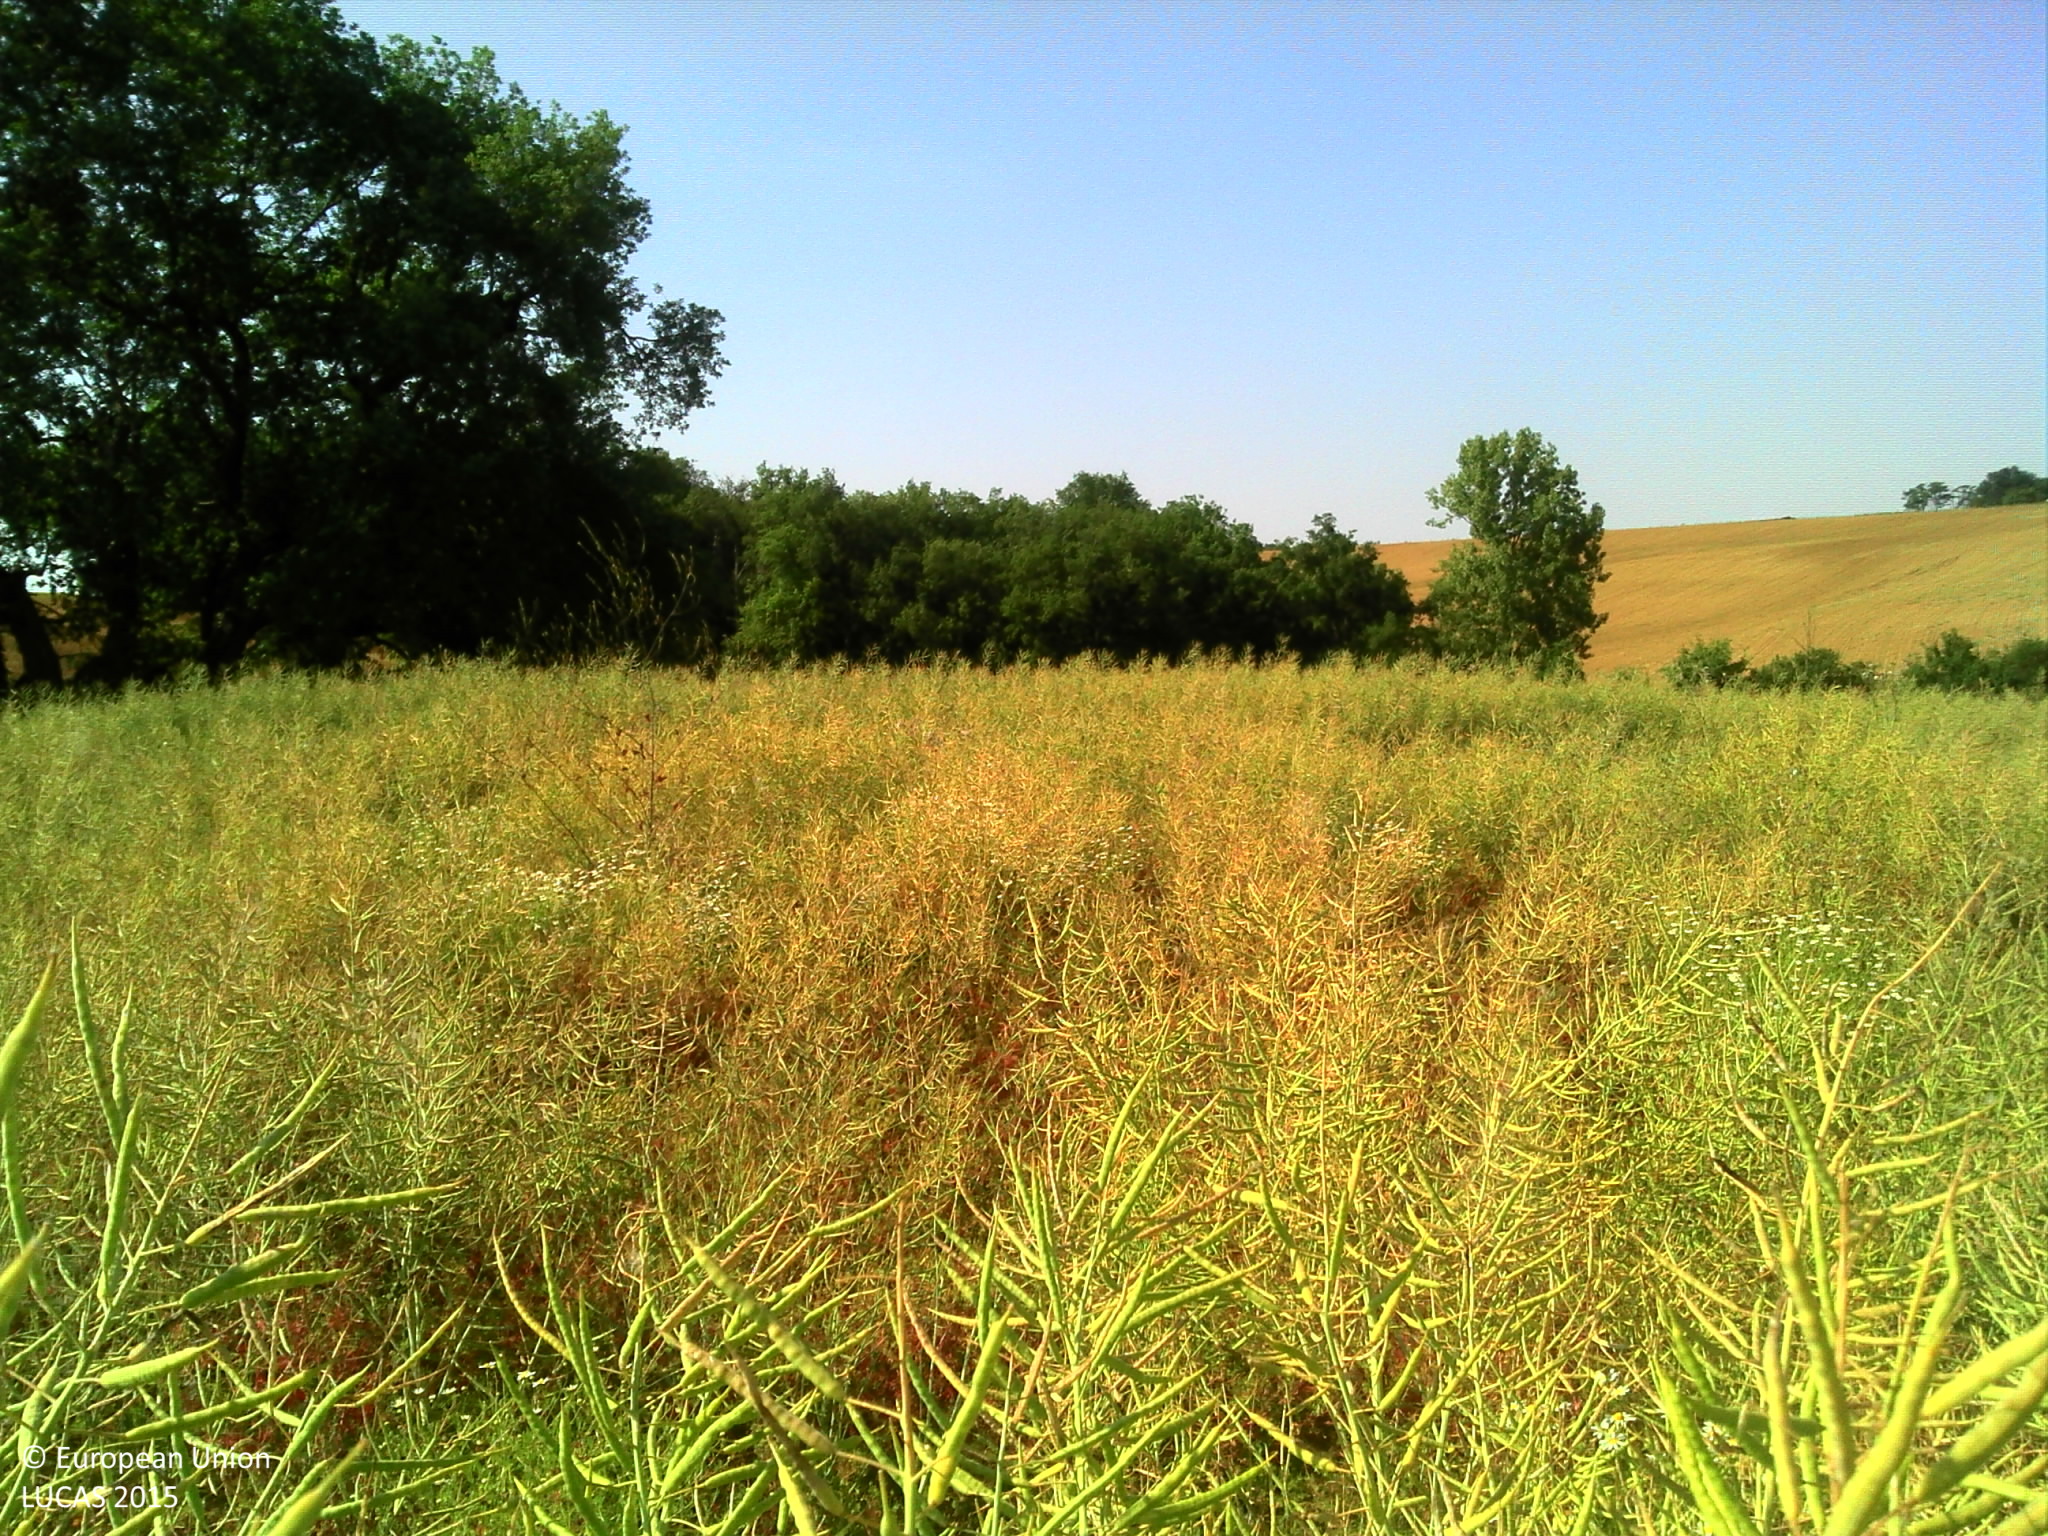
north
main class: Cropland
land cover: Rape and turnip rape
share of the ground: > 75 %
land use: Agriculture (excluding fallow land and kitchen gardens)
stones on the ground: < 10 %
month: June
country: FR
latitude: 43.6832
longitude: 0.7568
